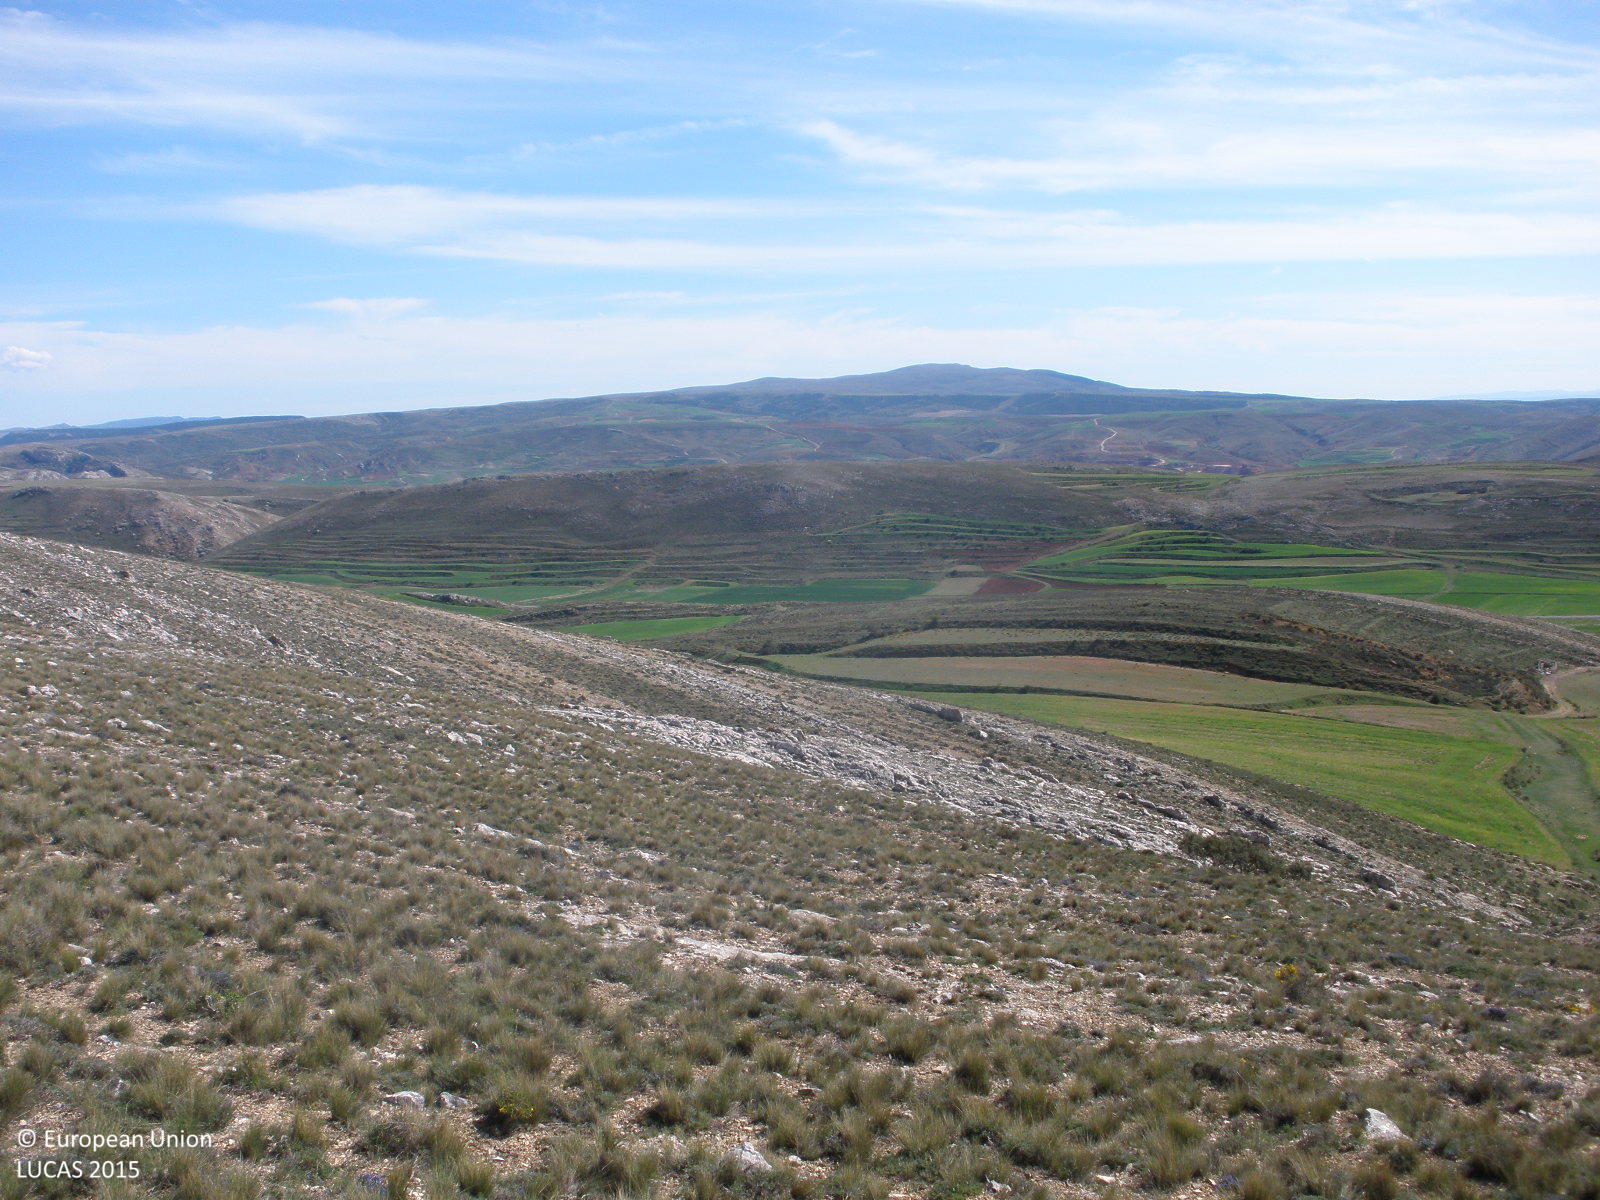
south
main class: Shrubland
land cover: Shrubland without tree cover
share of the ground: 50 - 75 %
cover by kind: shrubs 40 %, consolidated bare surface 35 %, herbaceous plants 25 %
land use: Semi-natural and natural areas not in use
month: May
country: ES
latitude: 40.6836
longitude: -0.8624
